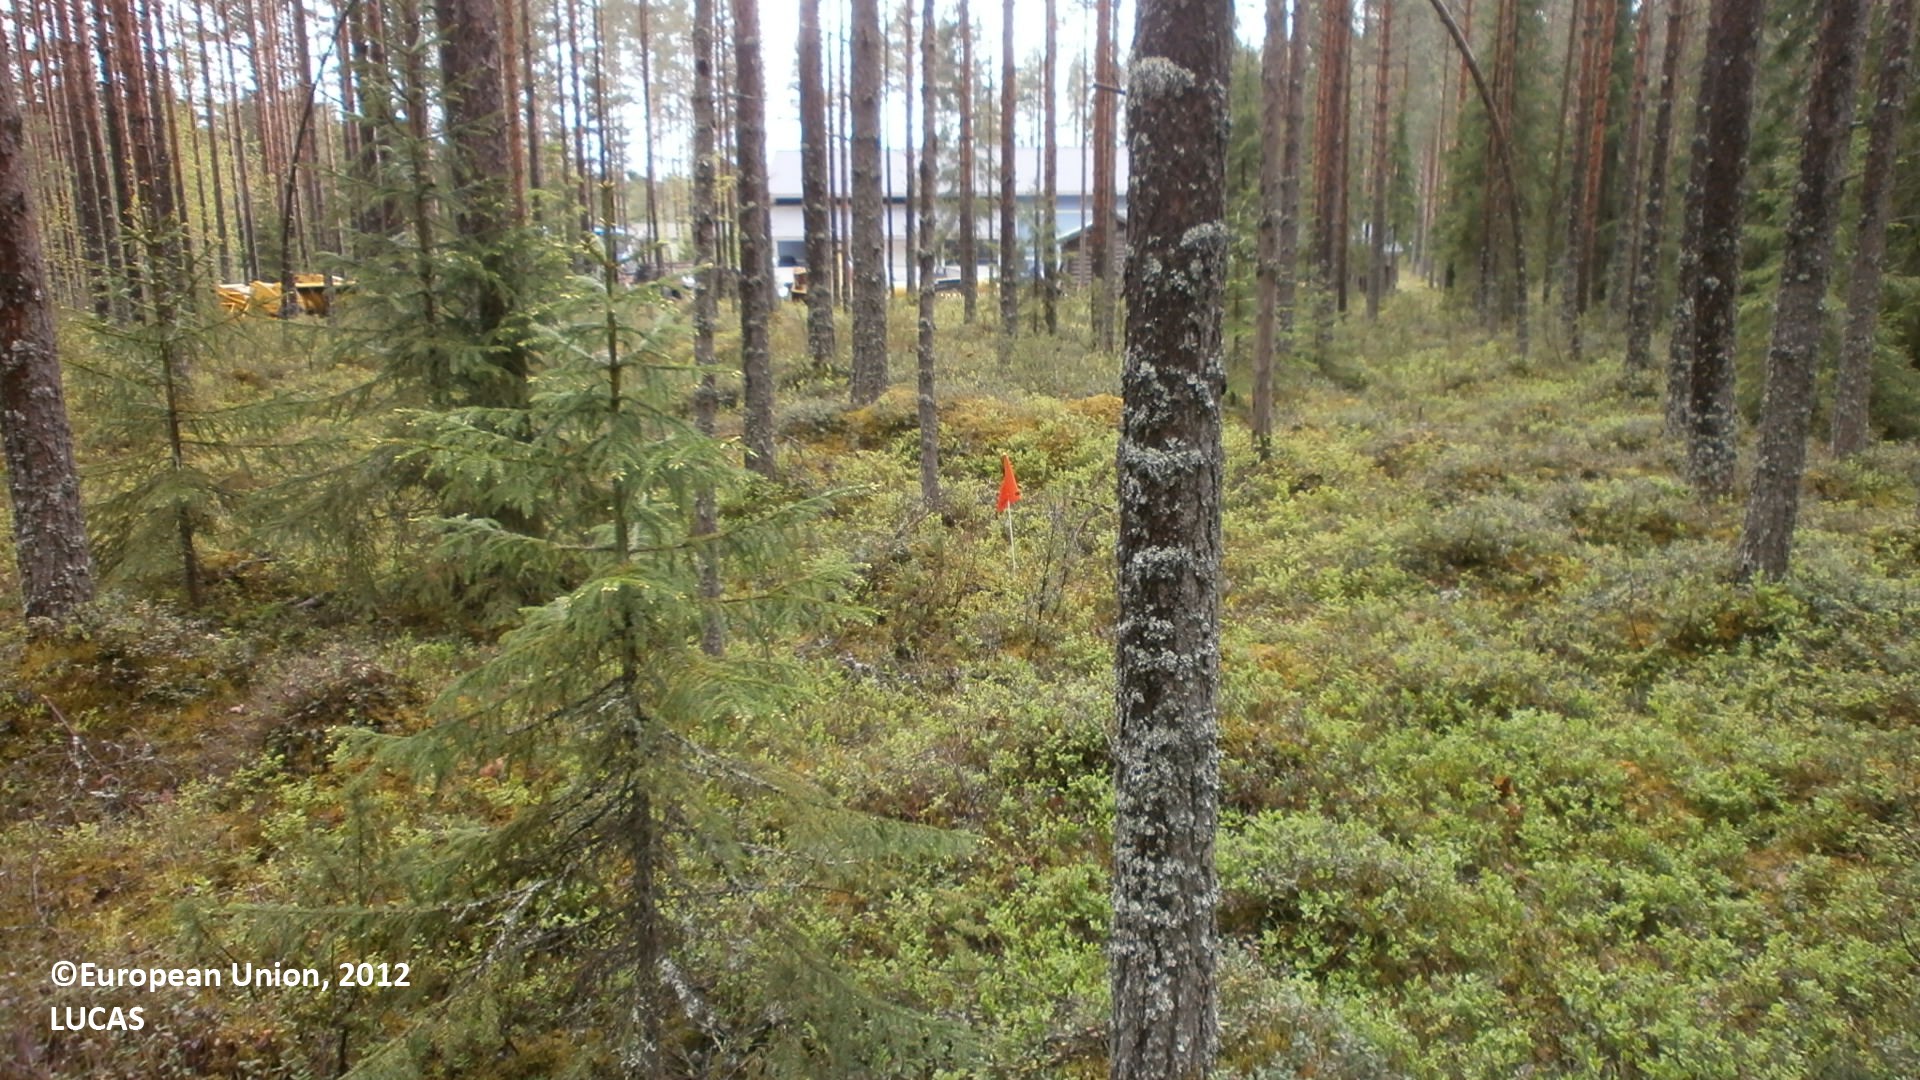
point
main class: Woodland
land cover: Pine dominated coniferous woodland
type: hemiboreal forest and nemoral coniferous forest and mixed broadleaved-coniferous forest
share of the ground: 25 - 50 %
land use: Forestry
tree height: > 5 m
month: June
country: FI
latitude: 64.0178
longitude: 26.0462
